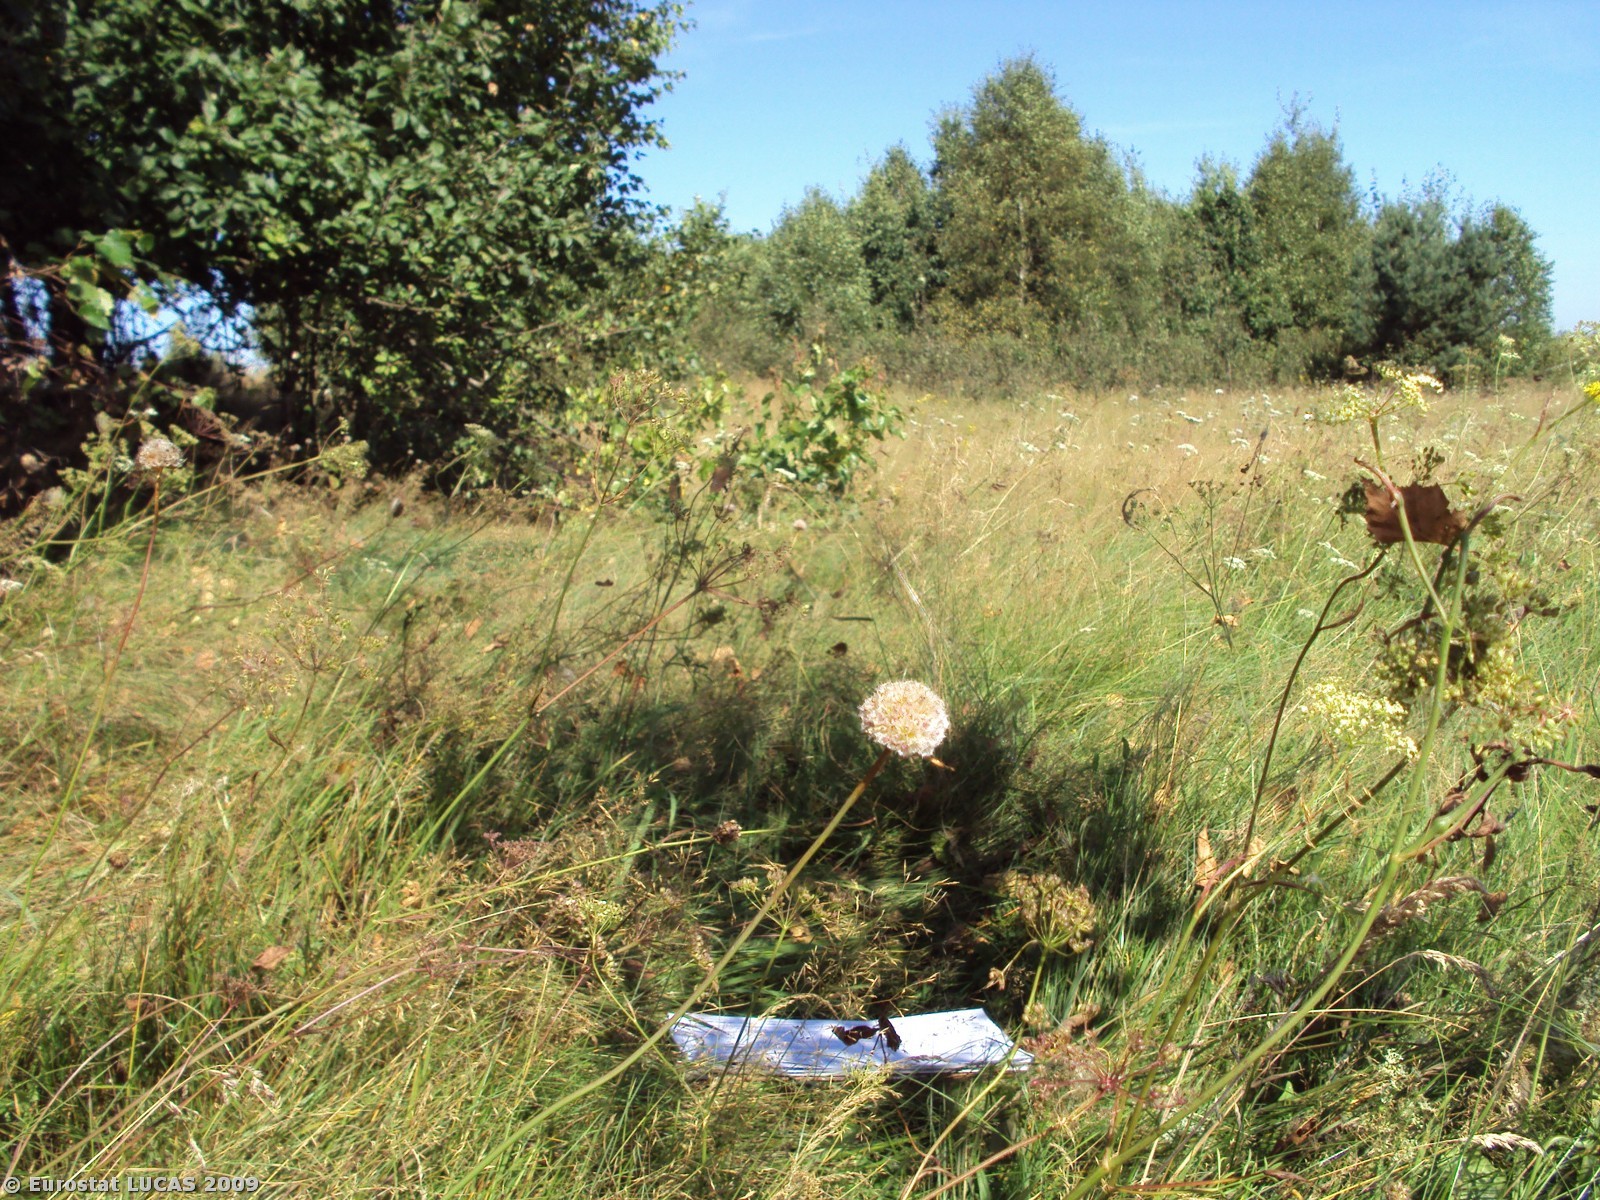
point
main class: Grassland
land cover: Grassland without tree/shrub cover
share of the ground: > 75 %
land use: Agriculture (excluding fallow land and kitchen gardens)
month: August
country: PL
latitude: 53.4877
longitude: 16.3511
